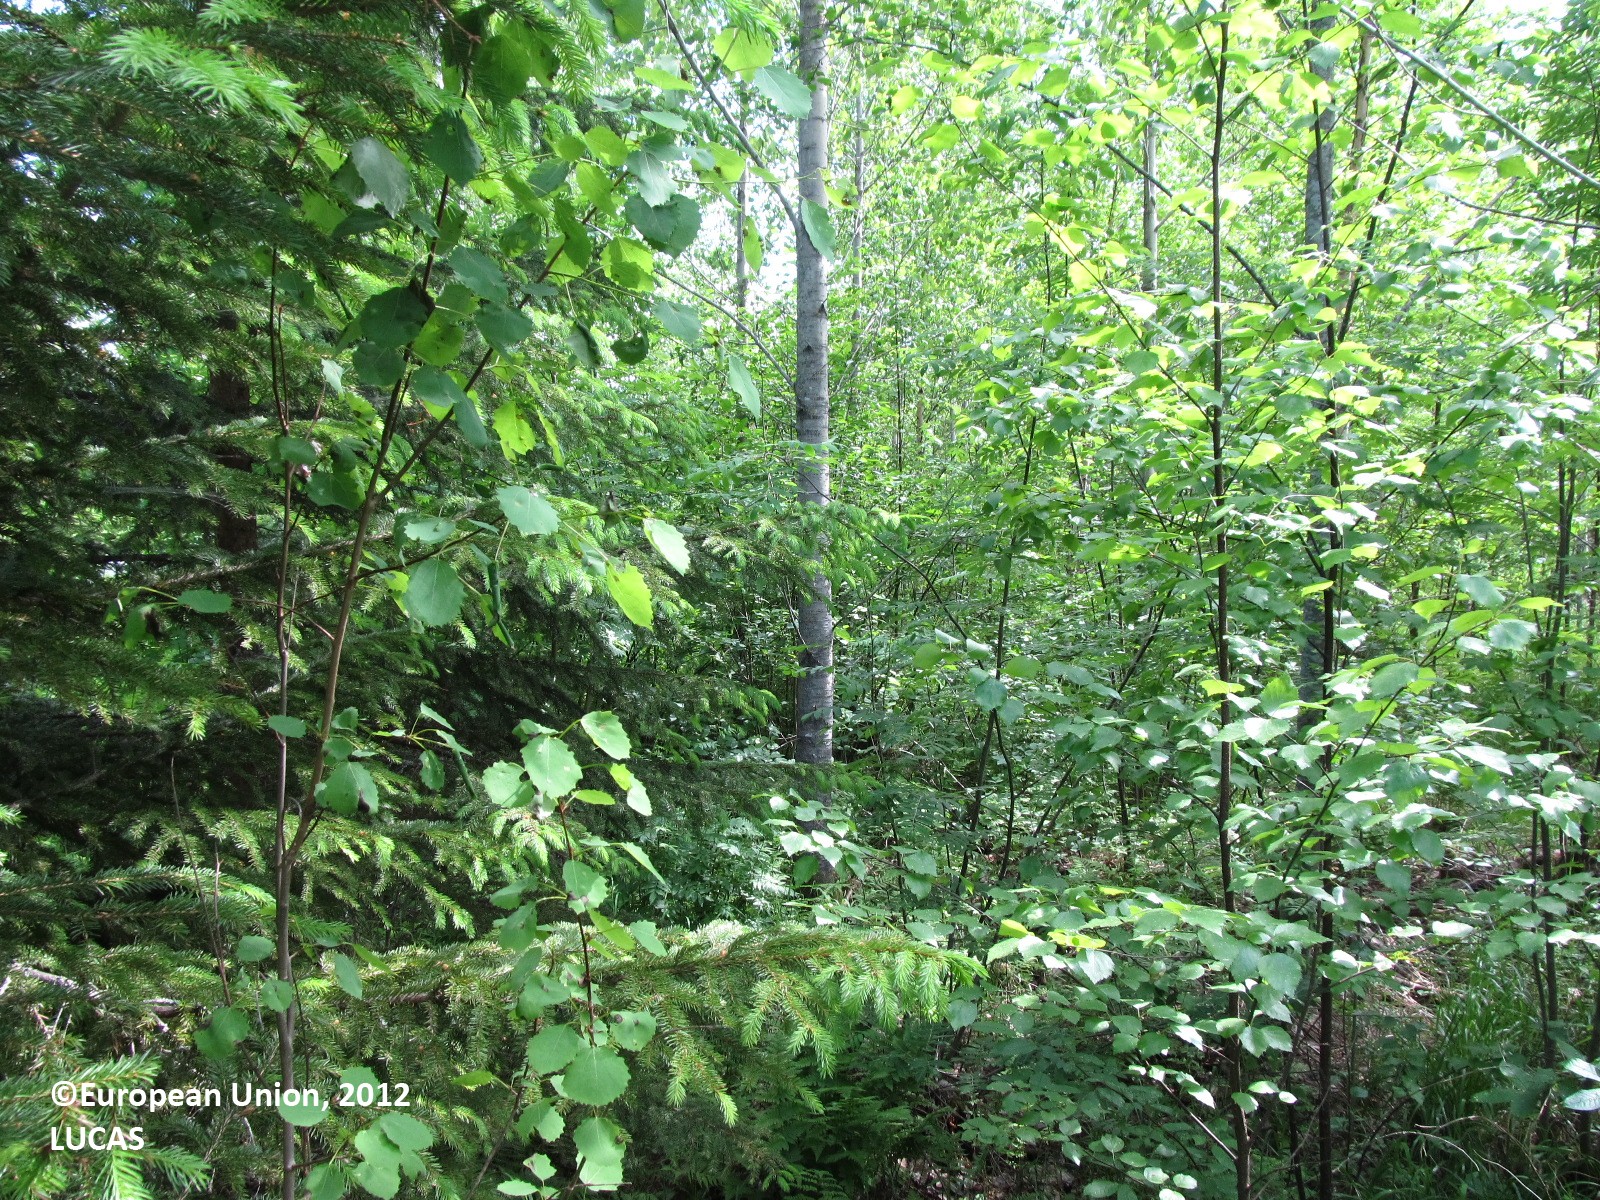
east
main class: Woodland
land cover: Broadleaved woodland
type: boreal forest
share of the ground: 50 - 75 %
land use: Forestry
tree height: > 5 m
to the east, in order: Broadleaved woodland; Ditches and canals; Grass margins; Paved roads, cycling and walking lanes; Lines of trees; Ditches and canals; Electric lines; Spruce dominated mixed woodland; Artificial constructions in urban areas; Grassland without tree/shrub cover; Rivers and streams; Spruce dominated coniferous woodland; Broadleaved woodland; Pine dominated mixed woodland; Ditches and canals; Pine dominated coniferous woodland; Ditches and canals; Pine dominated coniferous woodland
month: June
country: FI
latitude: 62.8760
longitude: 27.4834
